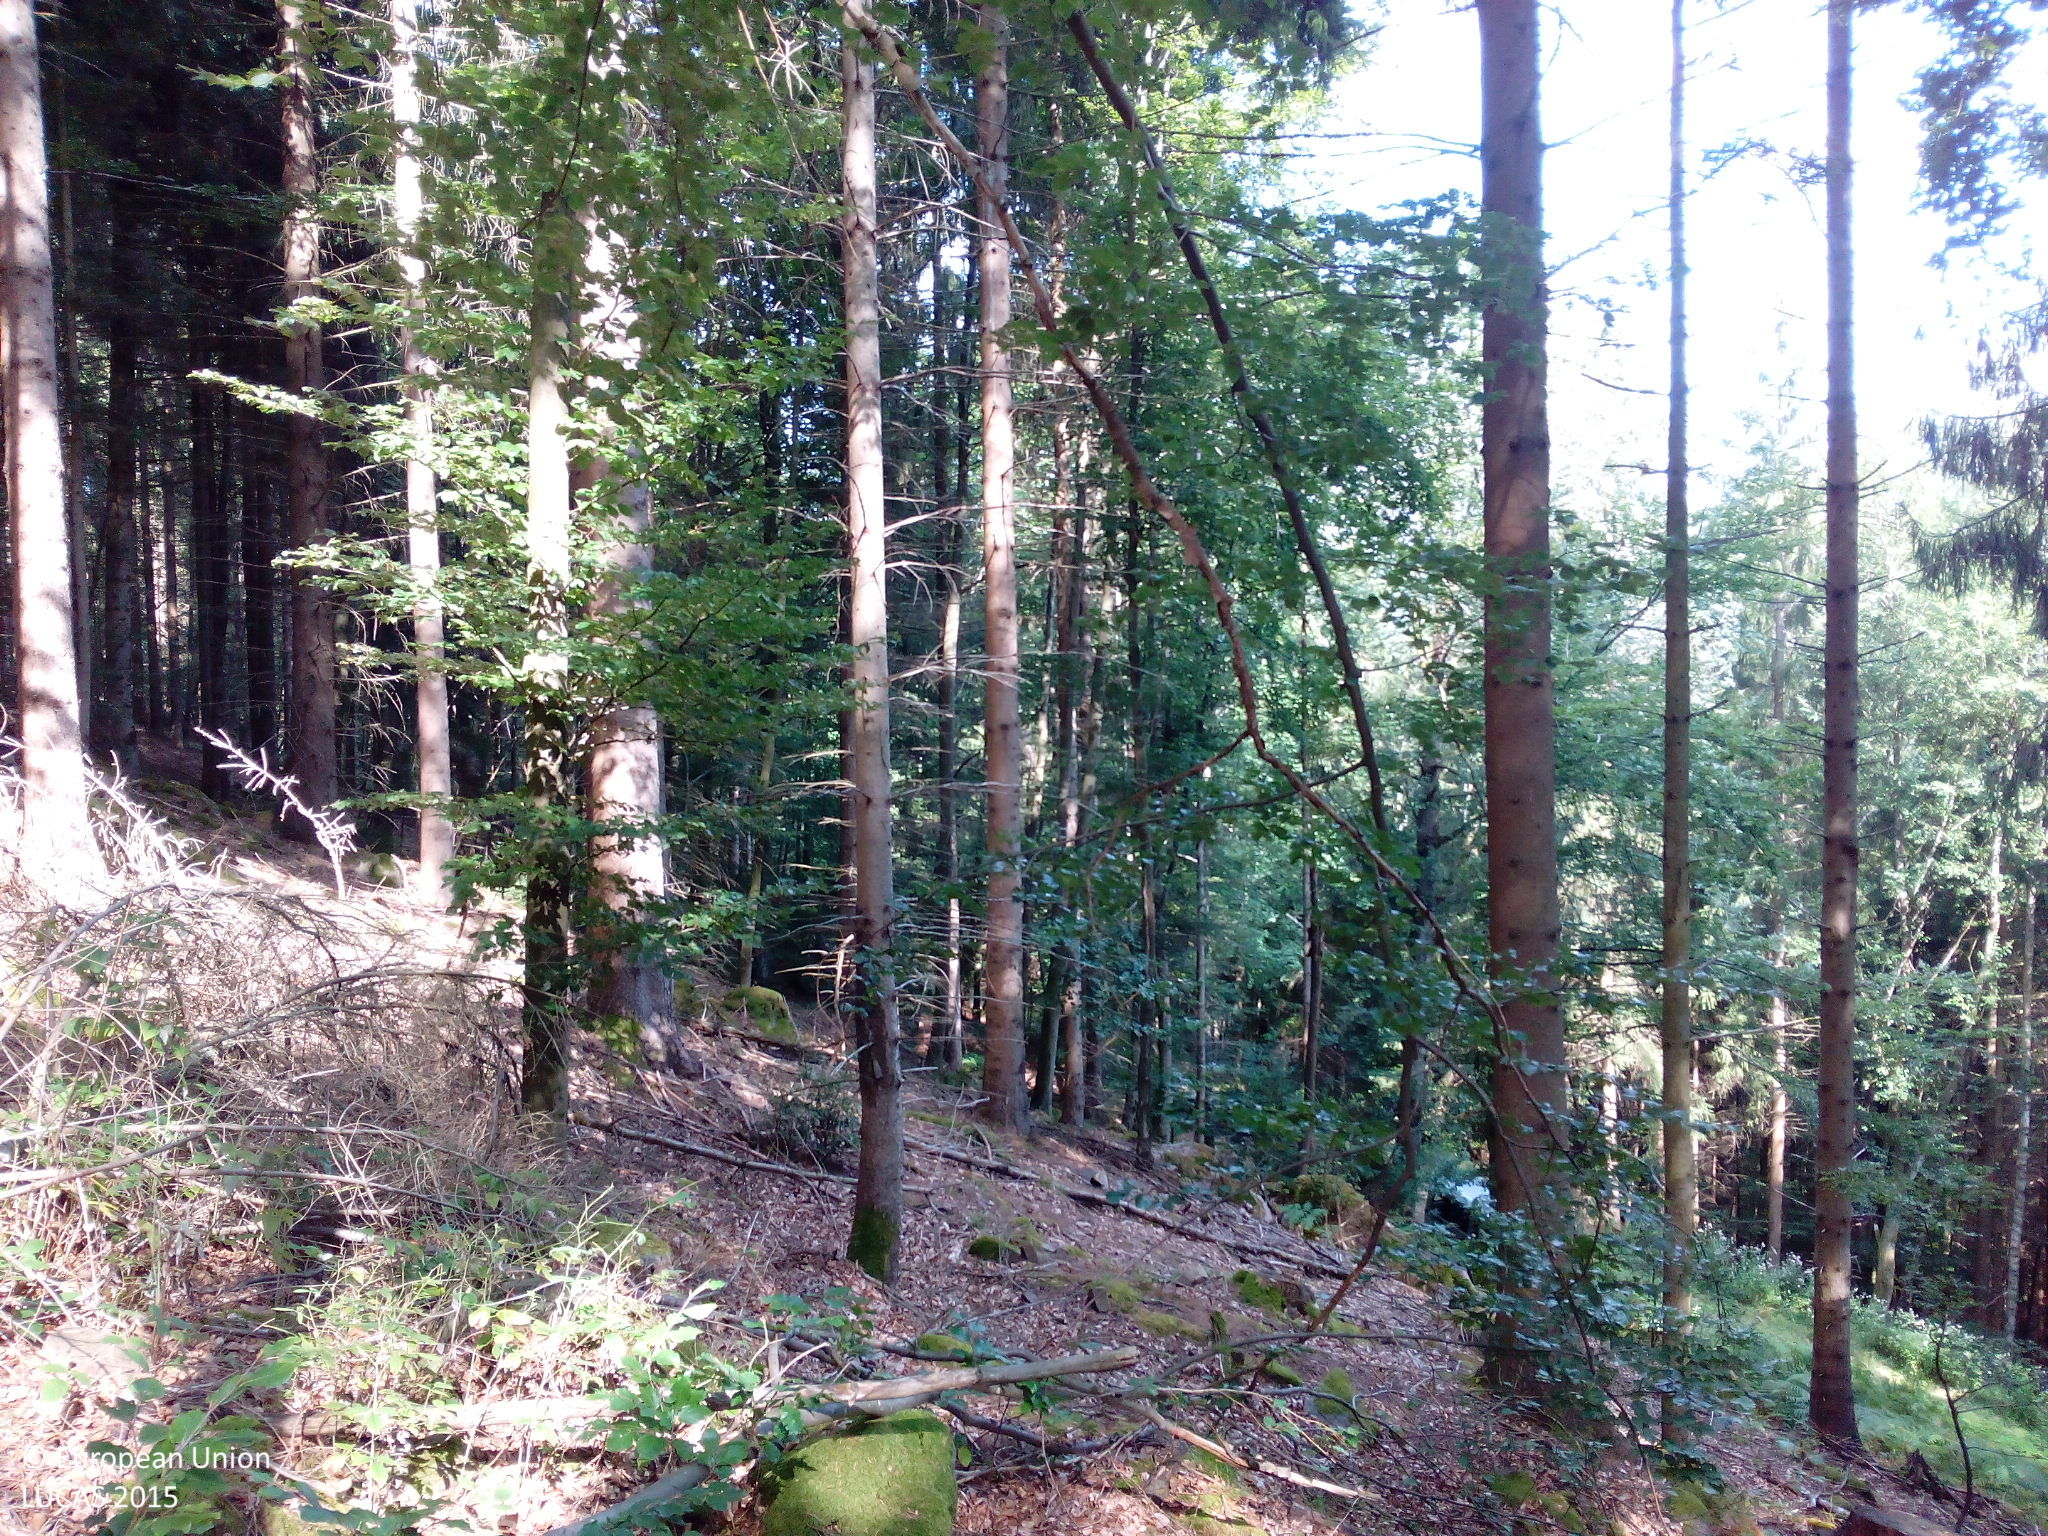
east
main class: Woodland
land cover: Spruce dominated mixed woodland
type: hemiboreal forest and nemoral coniferous forest and mixed broadleaved-coniferous forest
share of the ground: > 75 %
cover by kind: coniferous forest trees 65 %, broadleaved forest trees 25 %, lichens and mosses 5 %, unconsolidated bare surface 5 %
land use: Forestry
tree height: > 5 m
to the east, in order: Spruce dominated mixed woodland; Tracks; Spruce dominated mixed woodland; Spruce dominated coniferous woodland
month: August
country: DE
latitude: 48.8261
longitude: 8.5704
